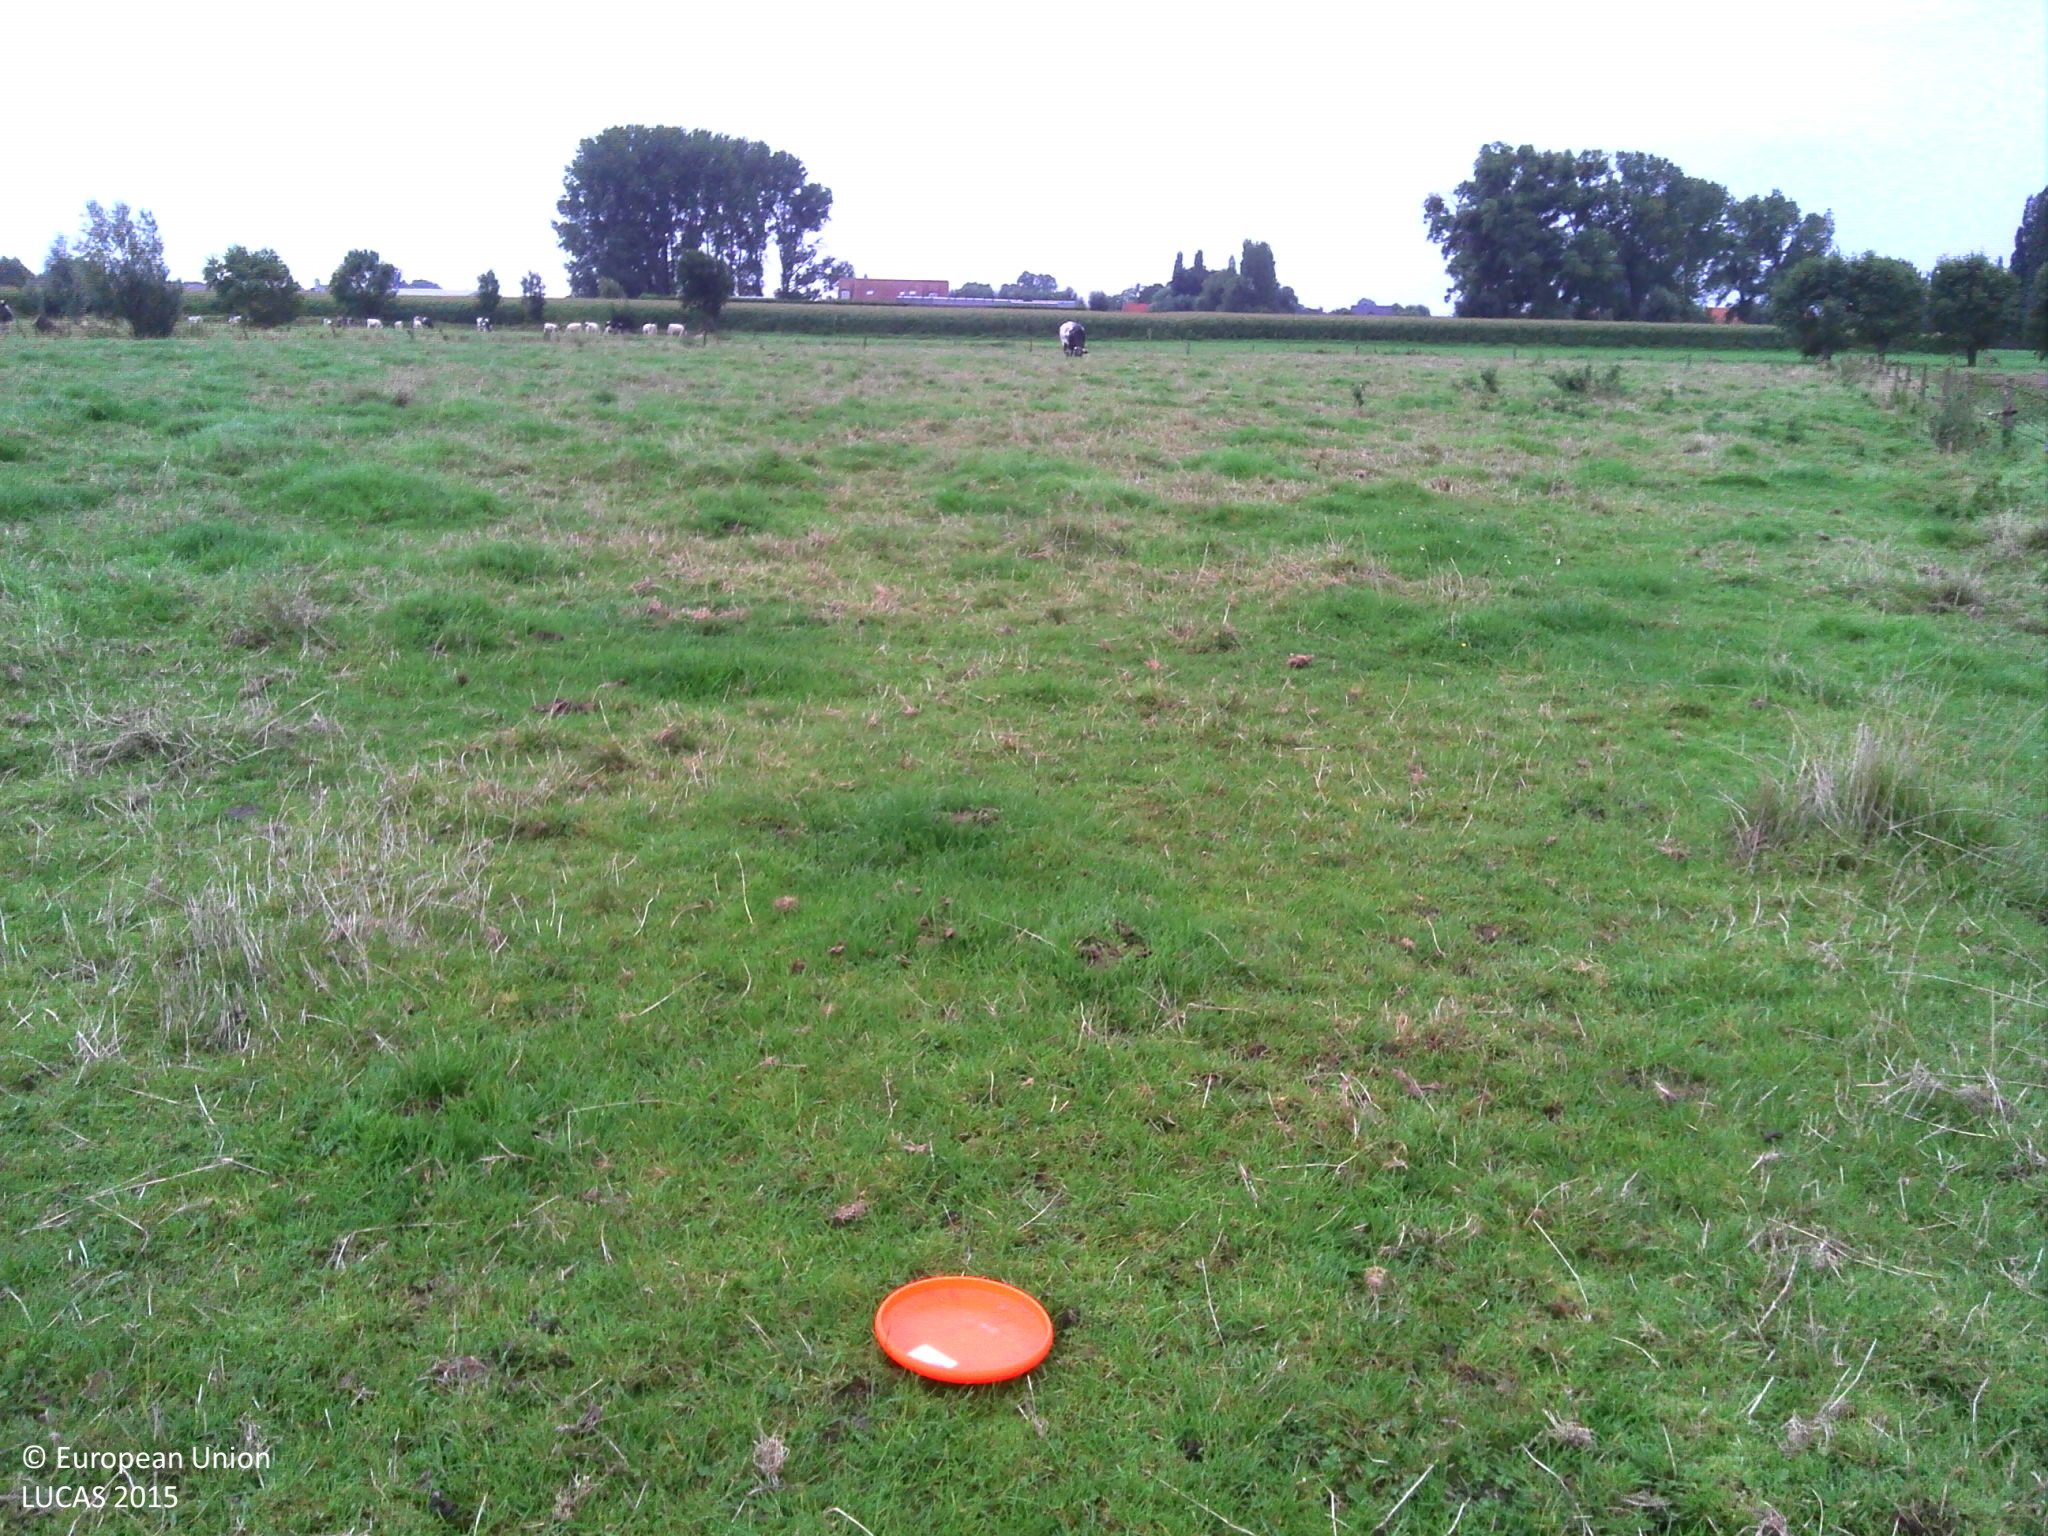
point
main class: Grassland
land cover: Grassland without tree/shrub cover
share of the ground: > 75 %
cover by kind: herbaceous plants 100 %
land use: Agriculture (excluding fallow land and kitchen gardens)
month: September
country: BE
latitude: 51.0403
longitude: 3.4170
